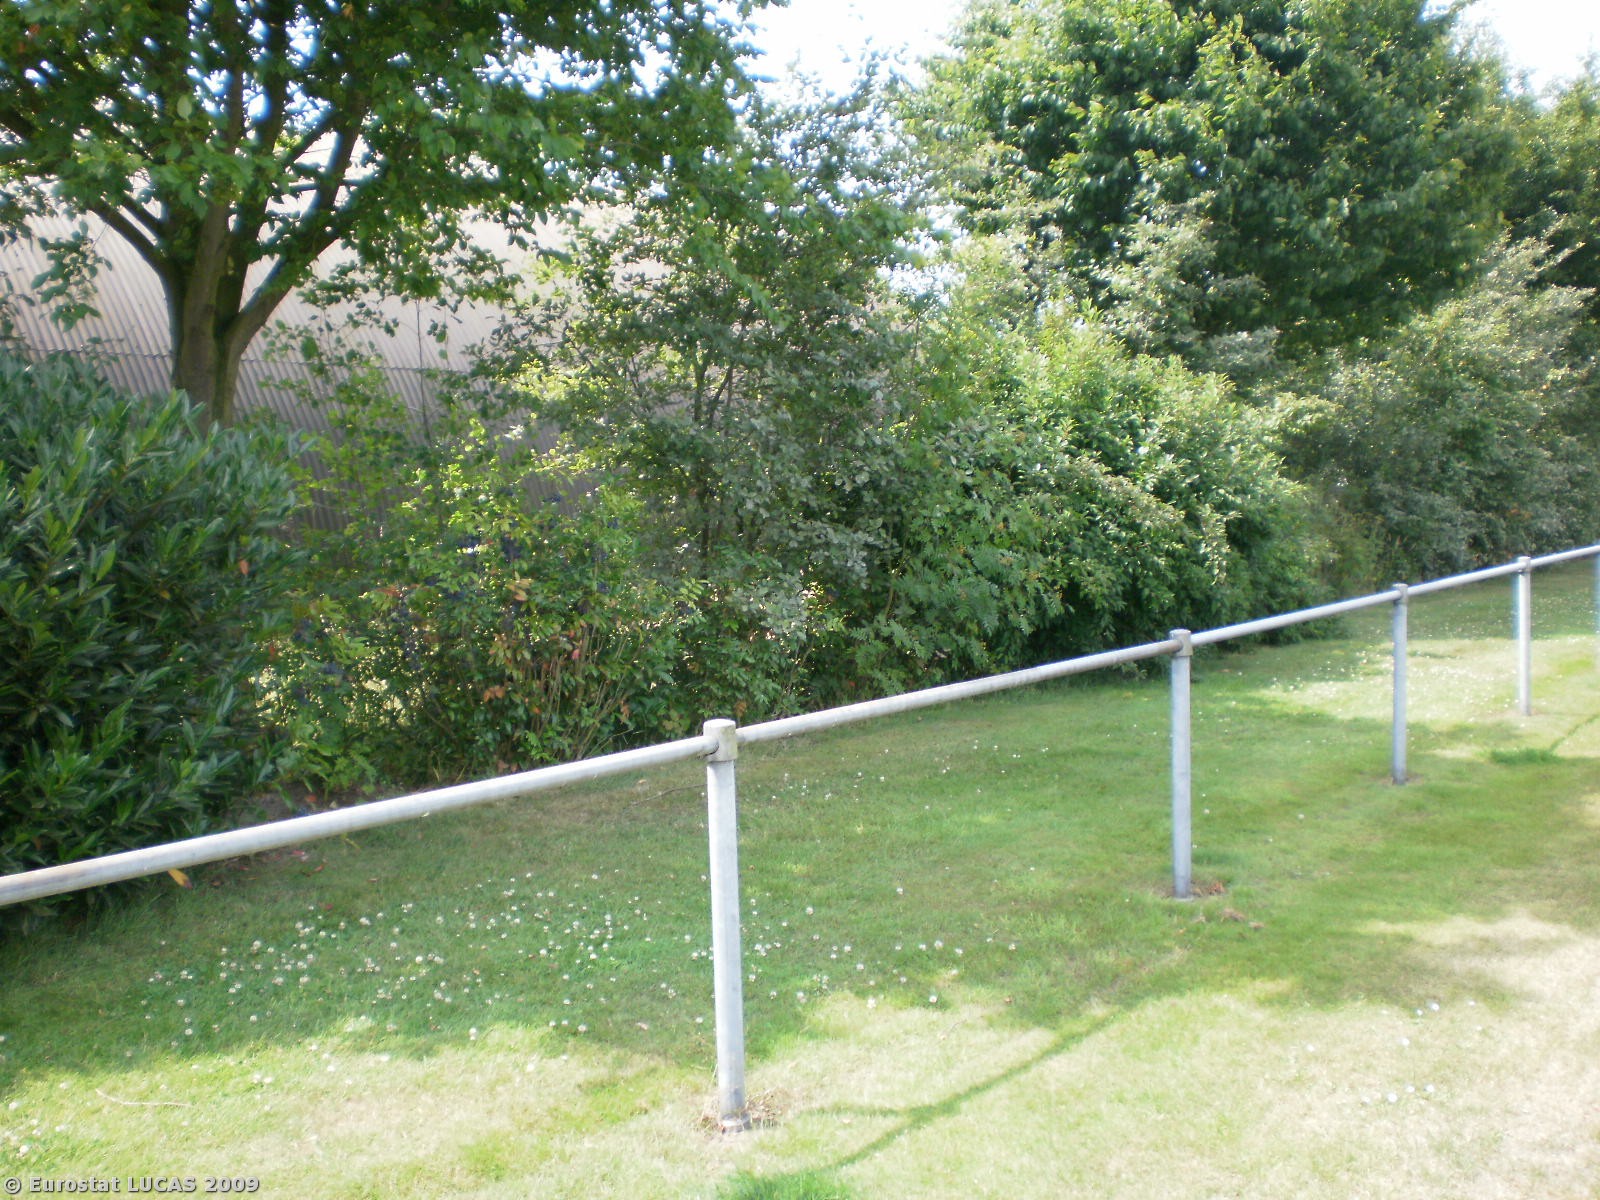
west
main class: Grassland
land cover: Grassland without tree/shrub cover
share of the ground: > 75 %
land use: Sport
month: July
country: BE
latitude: 51.2485
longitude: 5.5140
